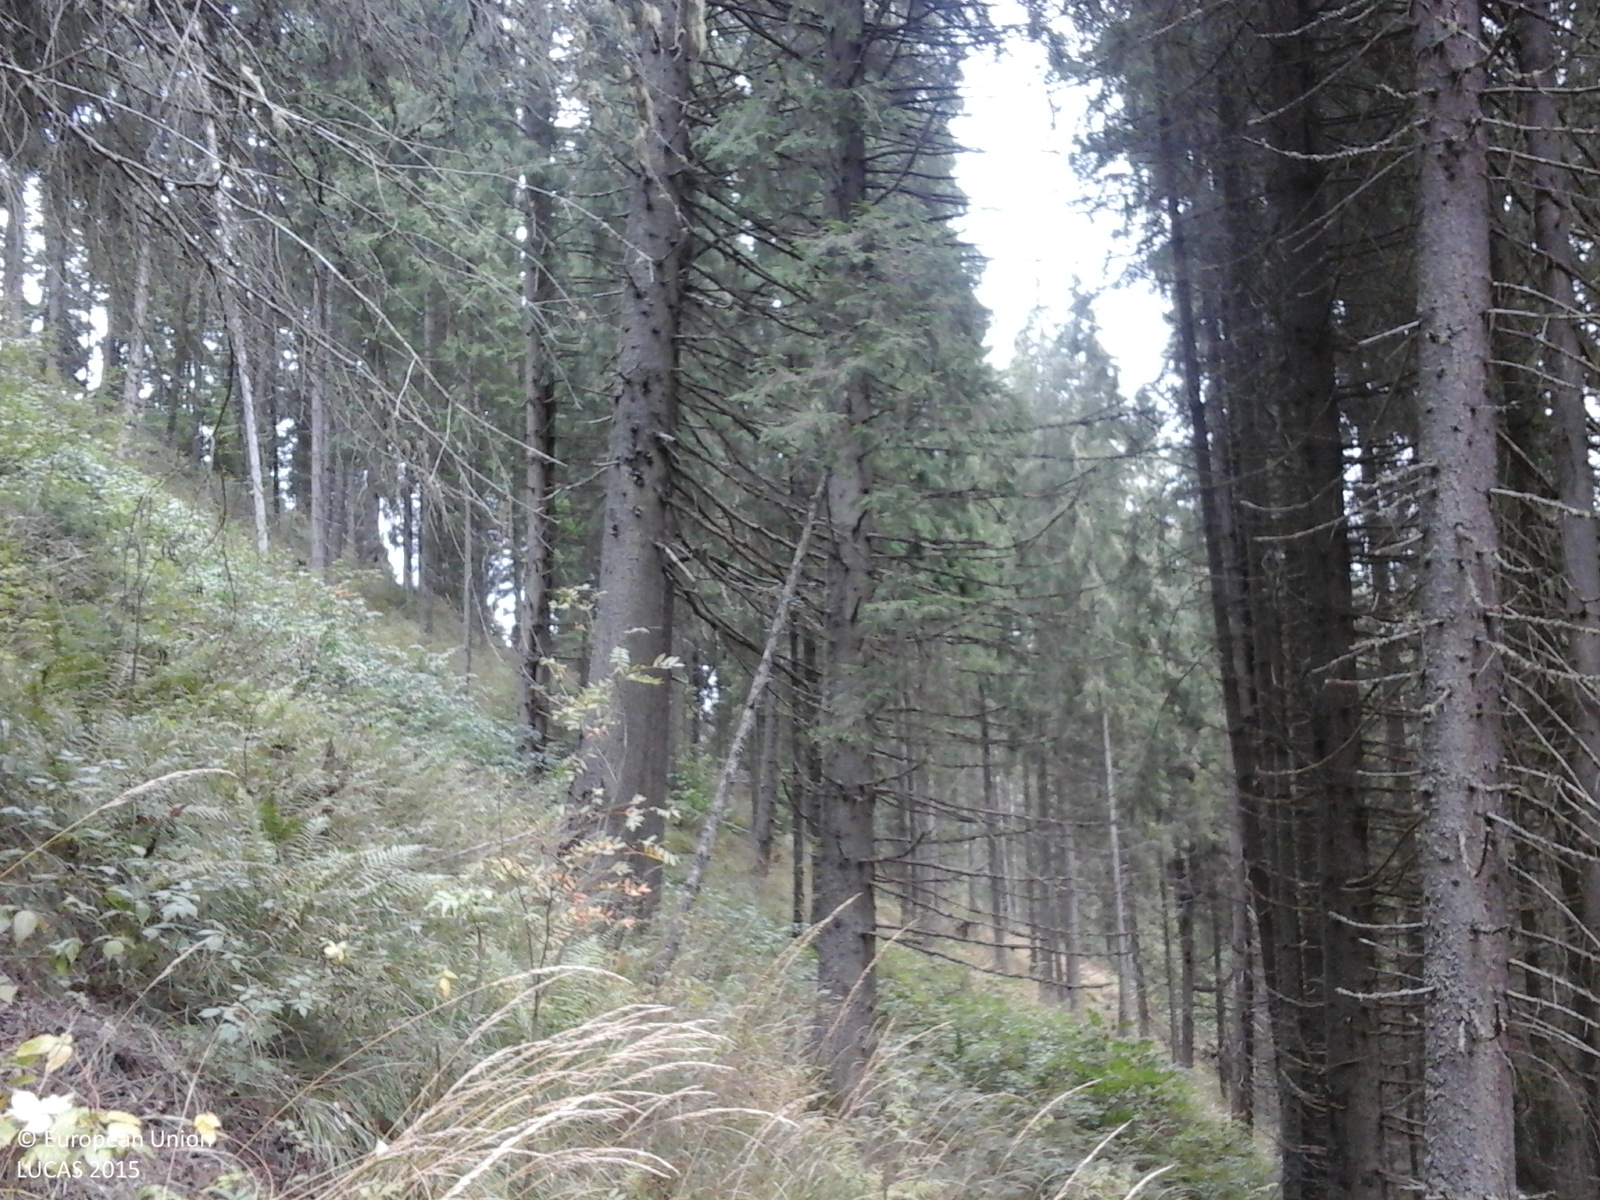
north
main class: Woodland
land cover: Spruce dominated coniferous woodland
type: alpine coniferous forest
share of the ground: > 75 %
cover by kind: coniferous forest trees 75 %, shrubs 10 %, herbaceous plants 10 %, broadleaved forest trees 5 %
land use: Forestry
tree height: > 5 m
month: September
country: RO
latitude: 46.6677
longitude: 22.9867
